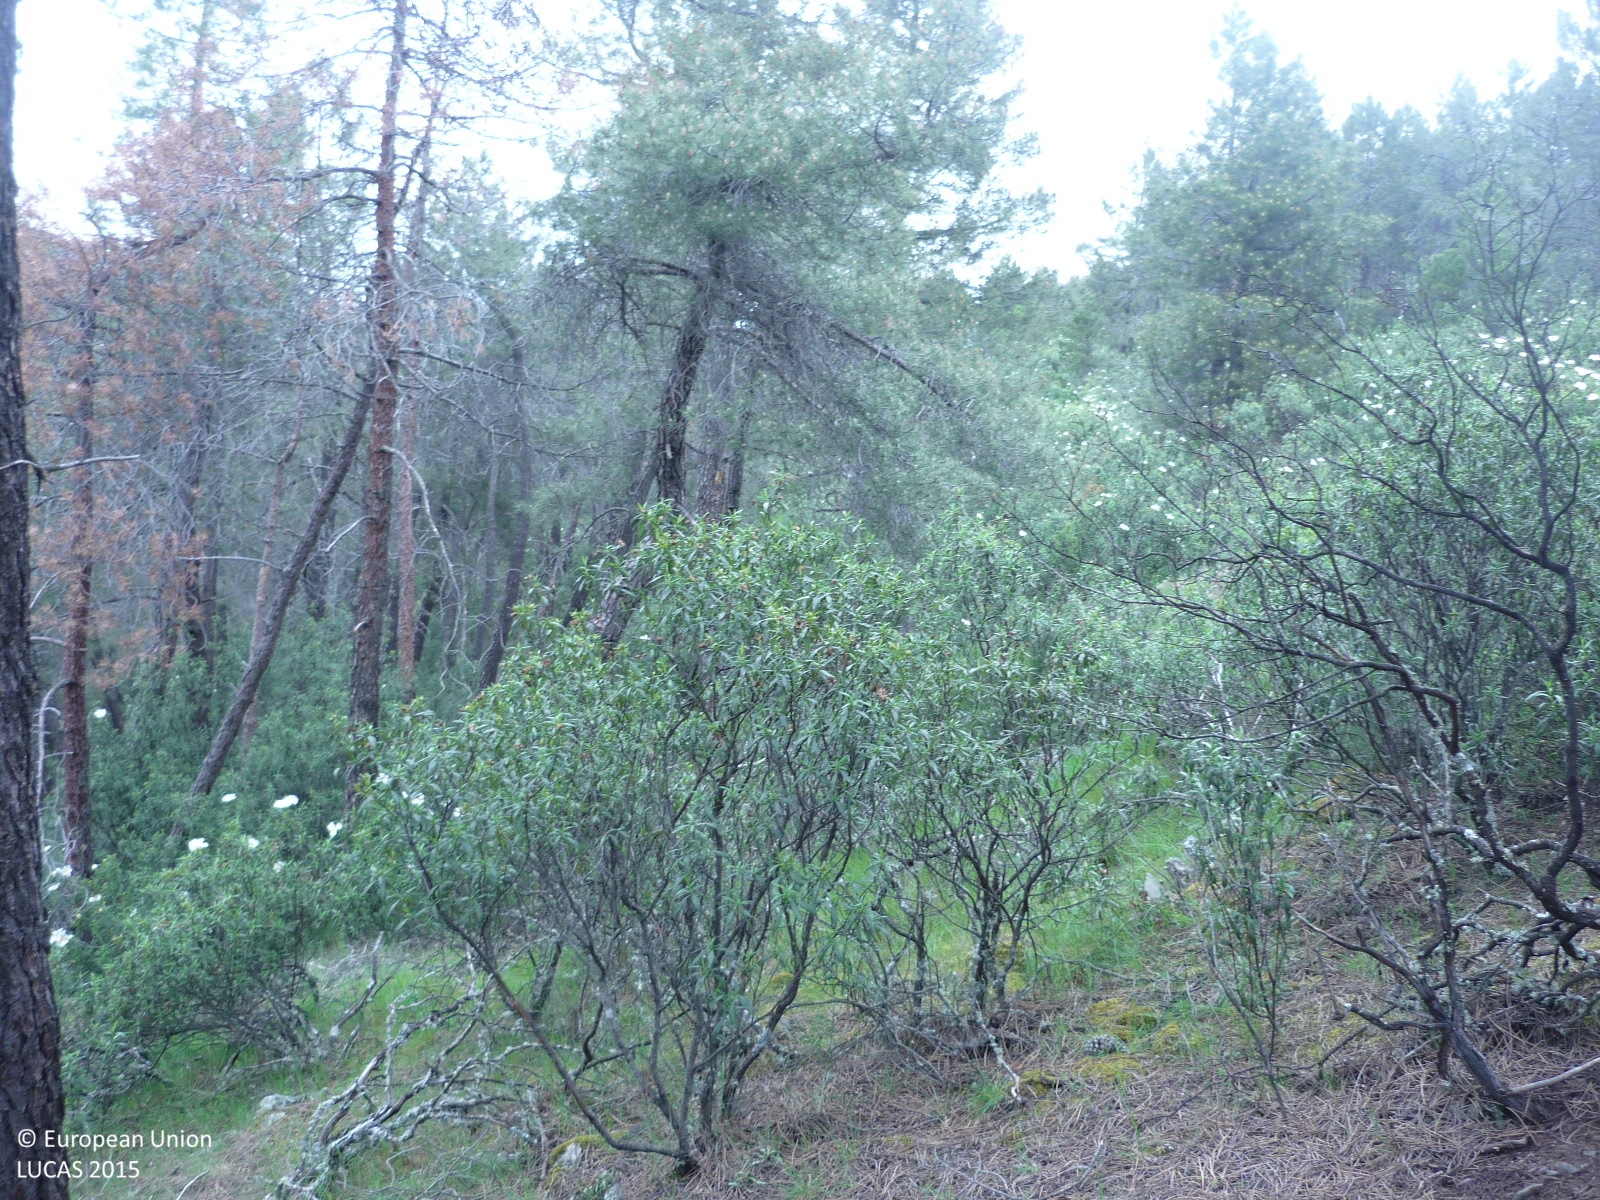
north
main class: Woodland
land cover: Pine dominated coniferous woodland
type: coniferous forest of the mediterranean region
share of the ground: > 75 %
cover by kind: coniferous forest trees 90 %, shrubs 10 %
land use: Forestry
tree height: > 5 m
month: April
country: ES
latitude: 40.8907
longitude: -3.4641
